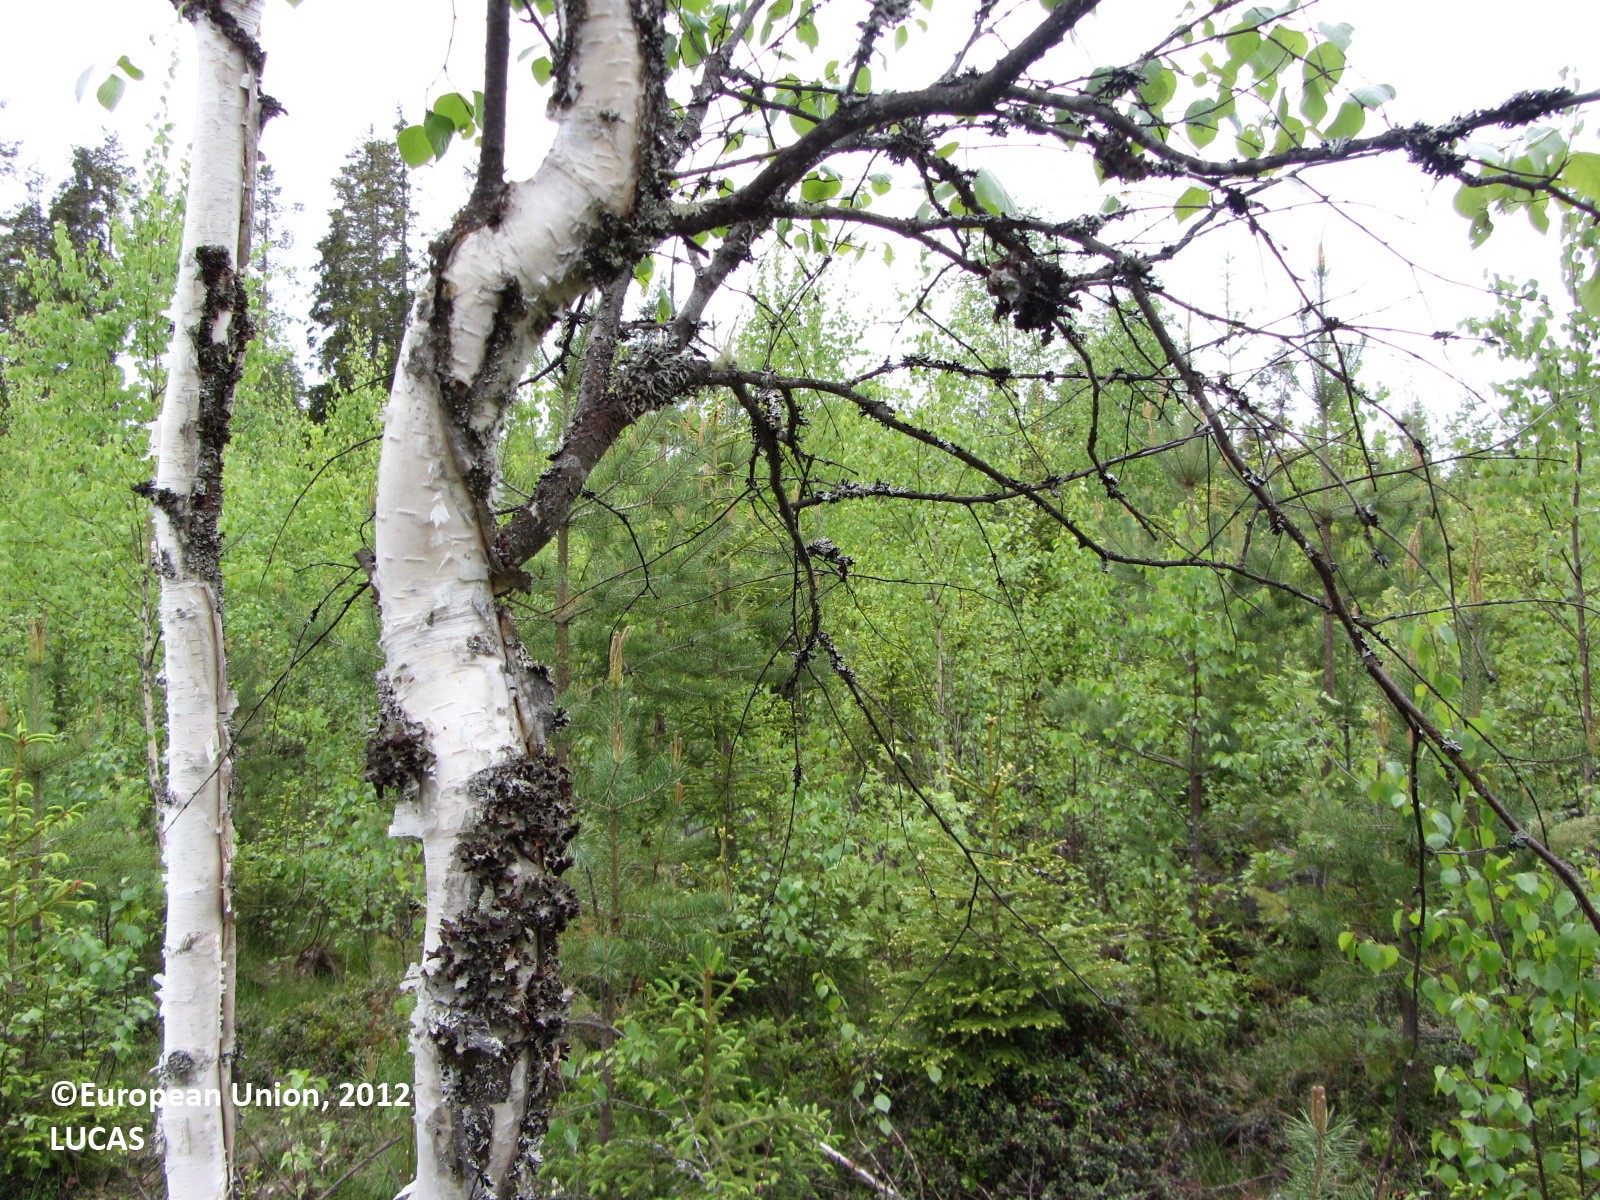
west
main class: Woodland
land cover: Other mixed woodland
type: hemiboreal forest and nemoral coniferous forest and mixed broadleaved-coniferous forest
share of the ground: > 75 %
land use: Forestry
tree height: < 5 m
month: June
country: FI
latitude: 61.7371
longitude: 24.8899
